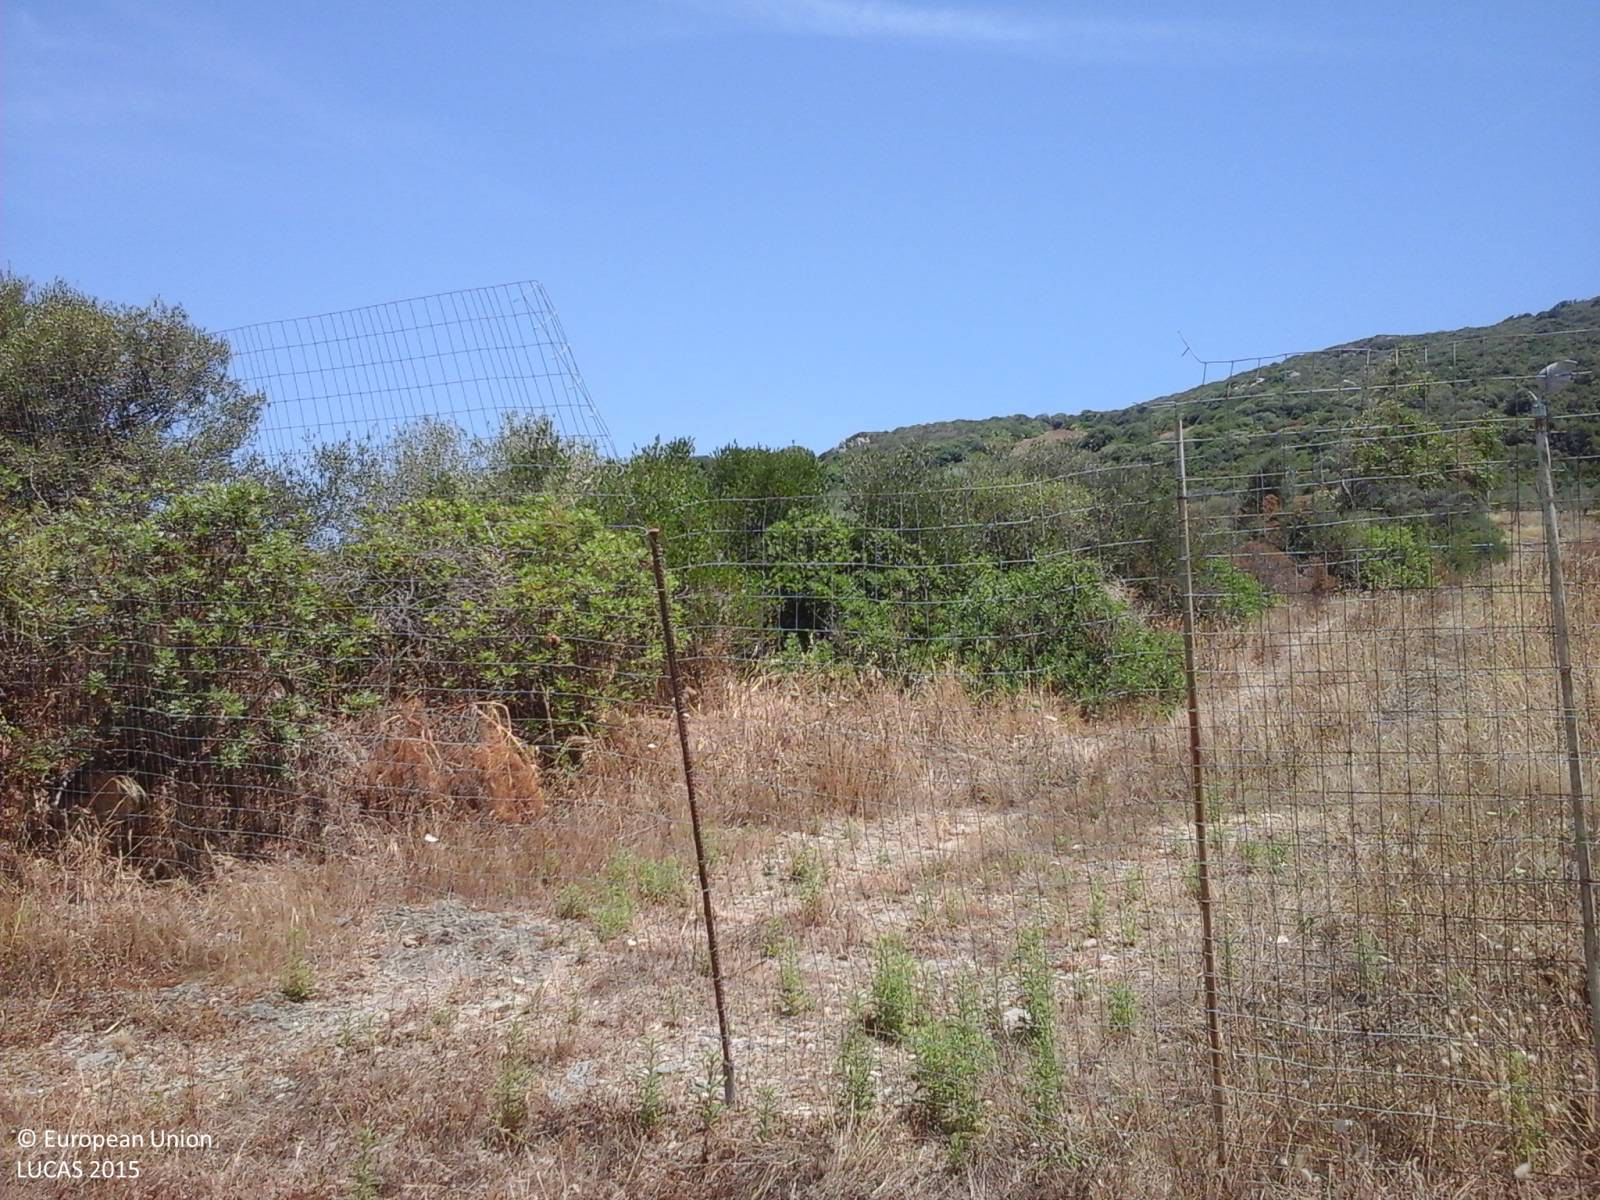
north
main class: Woodland
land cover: Other mixed woodland
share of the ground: 25 - 50 %
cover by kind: herbaceous plants 50 %, broadleaved forest trees 25 %, coniferous forest trees 10 %, unconsolidated bare surface 10 %, shrubs 5 %
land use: Residential
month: June
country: IT
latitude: 39.2242
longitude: 8.5610
